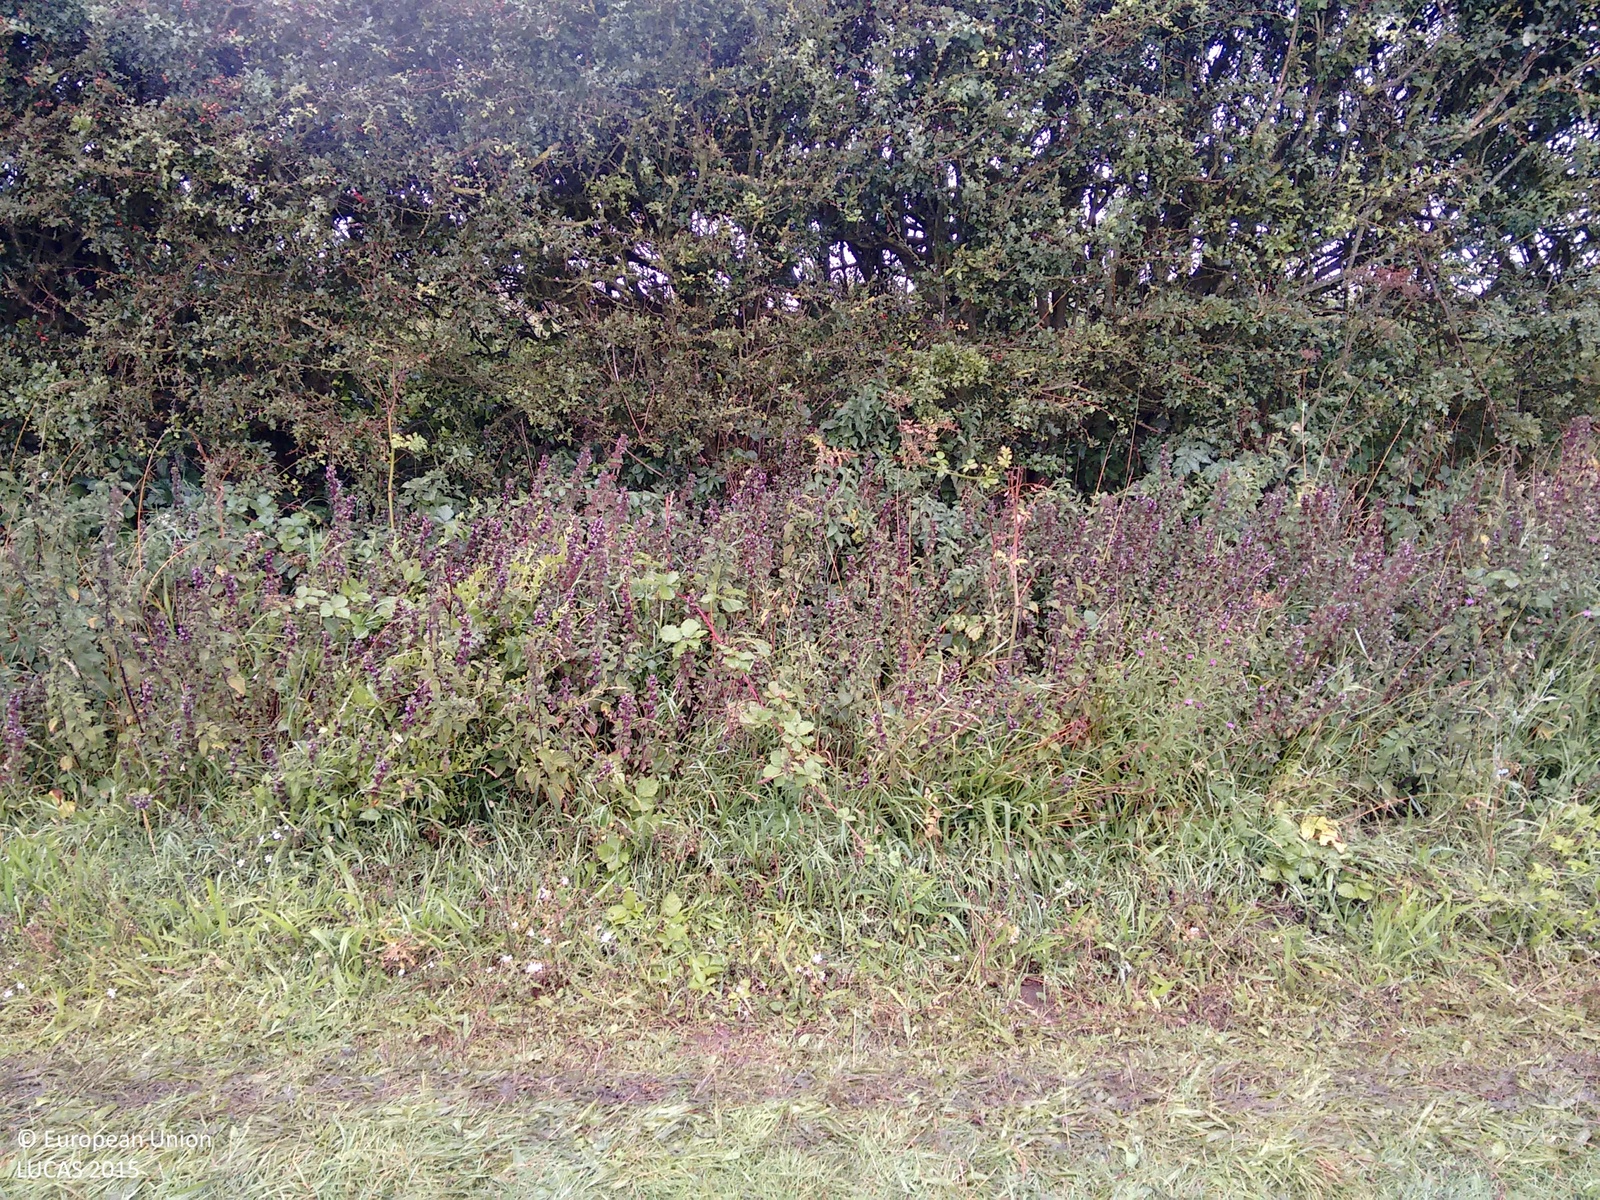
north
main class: Cropland
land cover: Sugar beet
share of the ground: > 75 %
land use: Agriculture (excluding fallow land and kitchen gardens)
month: August
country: GB
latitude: 52.9065
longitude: 0.8017
